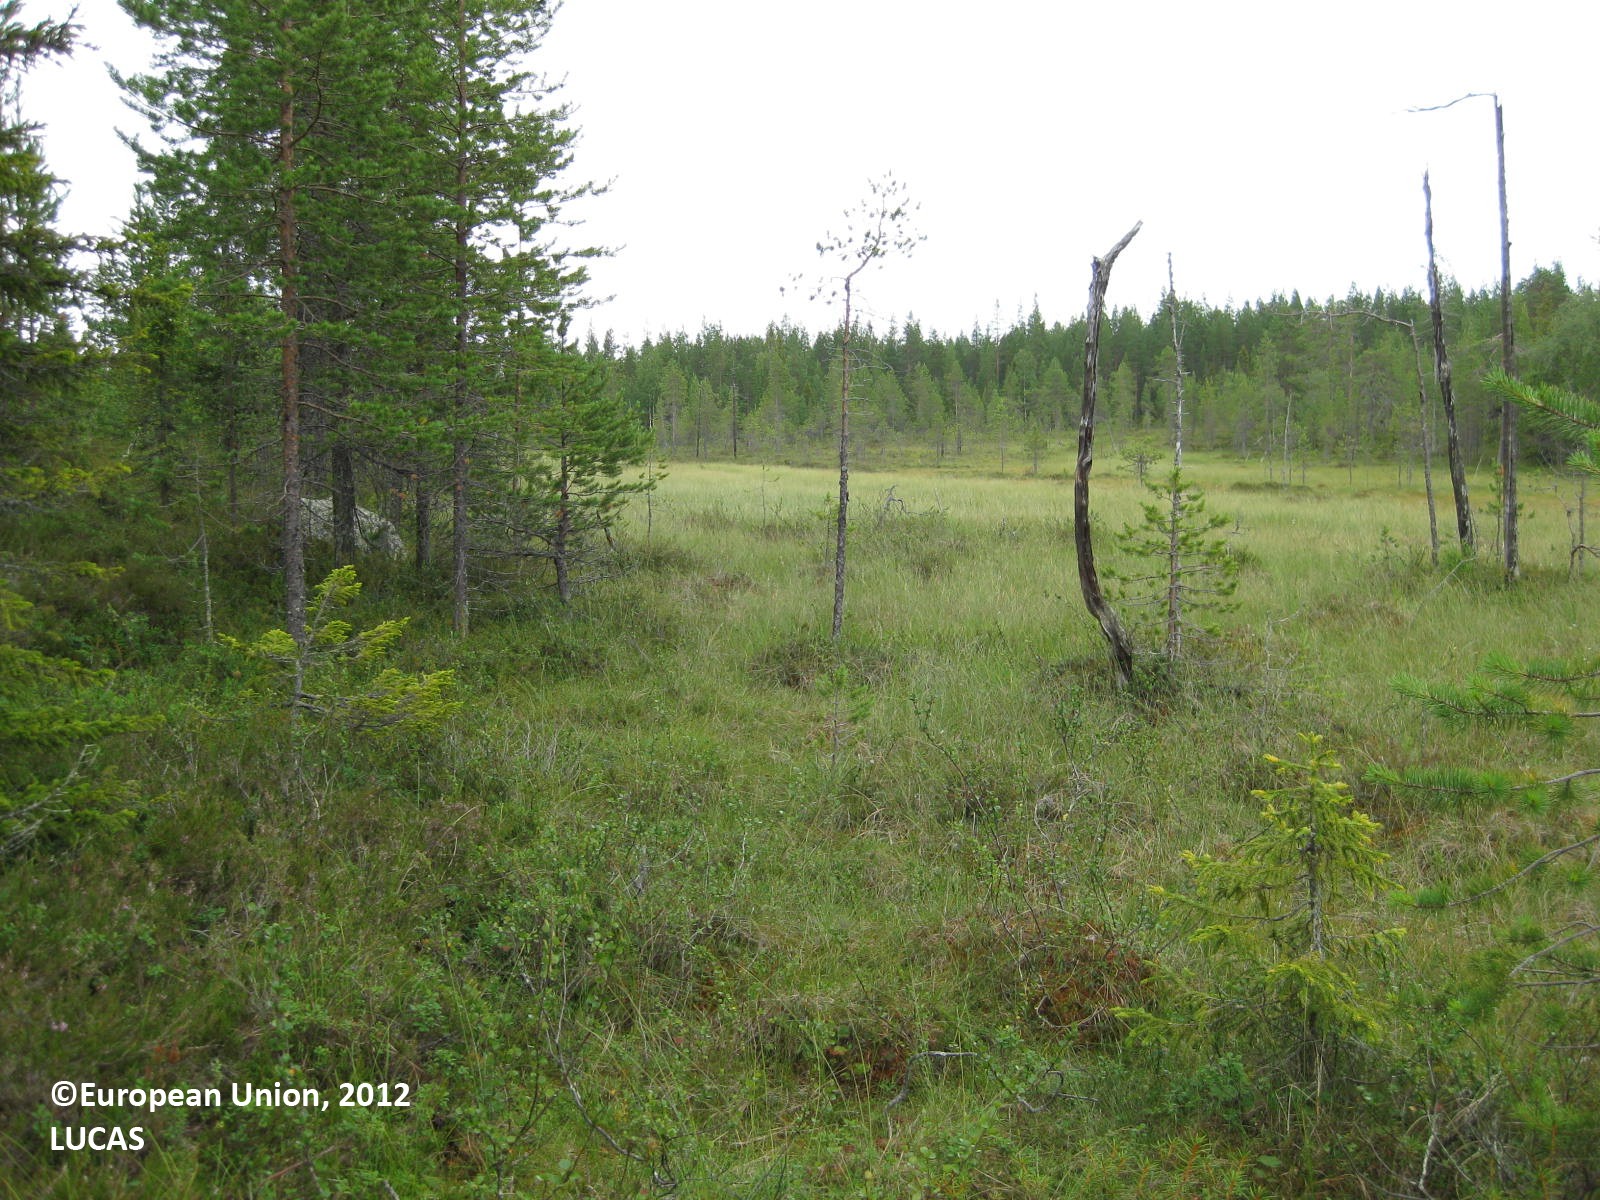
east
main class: Woodland
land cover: Pine dominated coniferous woodland
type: boreal forest
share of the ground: > 75 %
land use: Forestry
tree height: > 5 m
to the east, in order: Pine dominated coniferous woodland; Peatbogs; Pine dominated coniferous woodland; Tracks; Abandoned hedges; Tracks; Pine dominated coniferous woodland
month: July
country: FI
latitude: 65.9254
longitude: 28.5448
